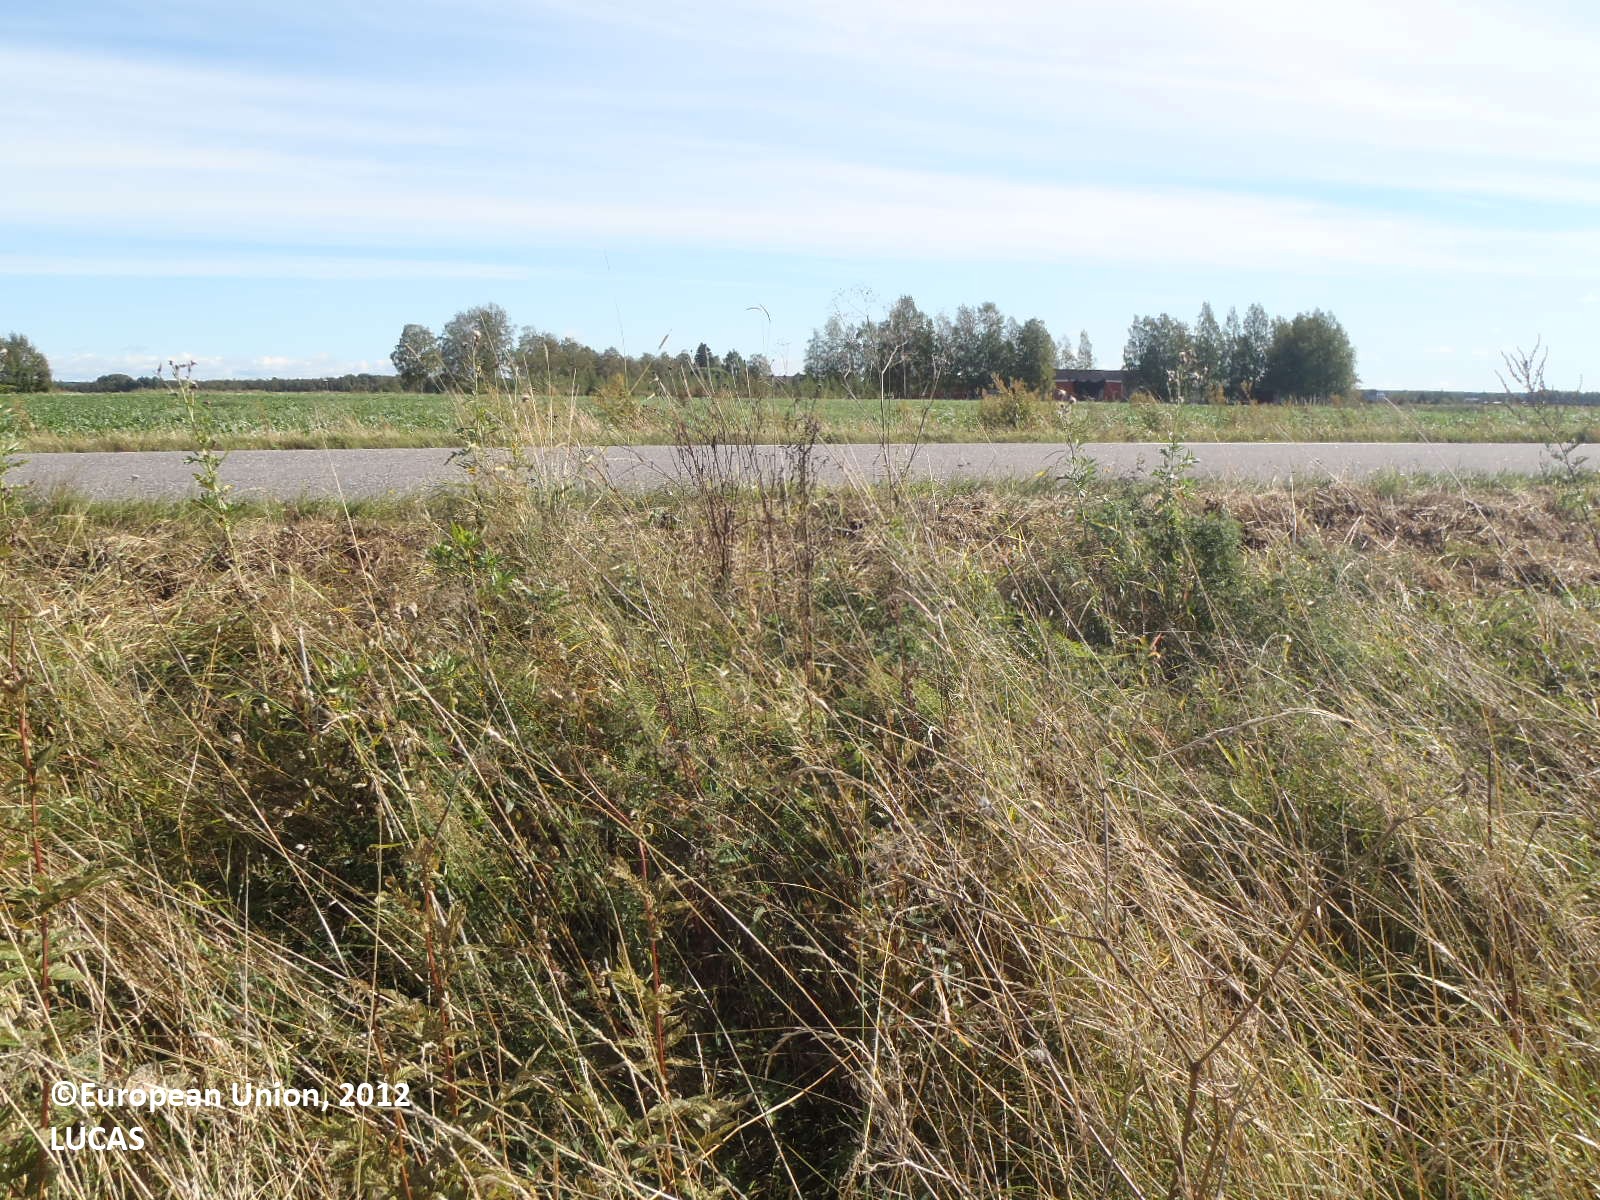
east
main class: Cropland
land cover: Common wheat
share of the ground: 25 - 50 %
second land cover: Barley
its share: 50 - 75 %
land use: Agriculture (excluding fallow land and kitchen gardens)
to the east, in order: Common wheat; Barley; Grass margins; Ditches and canals; Abandoned hedges; Grass margins; Paved roads, cycling and walking lanes; Grass margins; Ditches and canals; Grass margins; Sugar beet
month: September
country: FI
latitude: 61.0808
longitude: 22.3173
